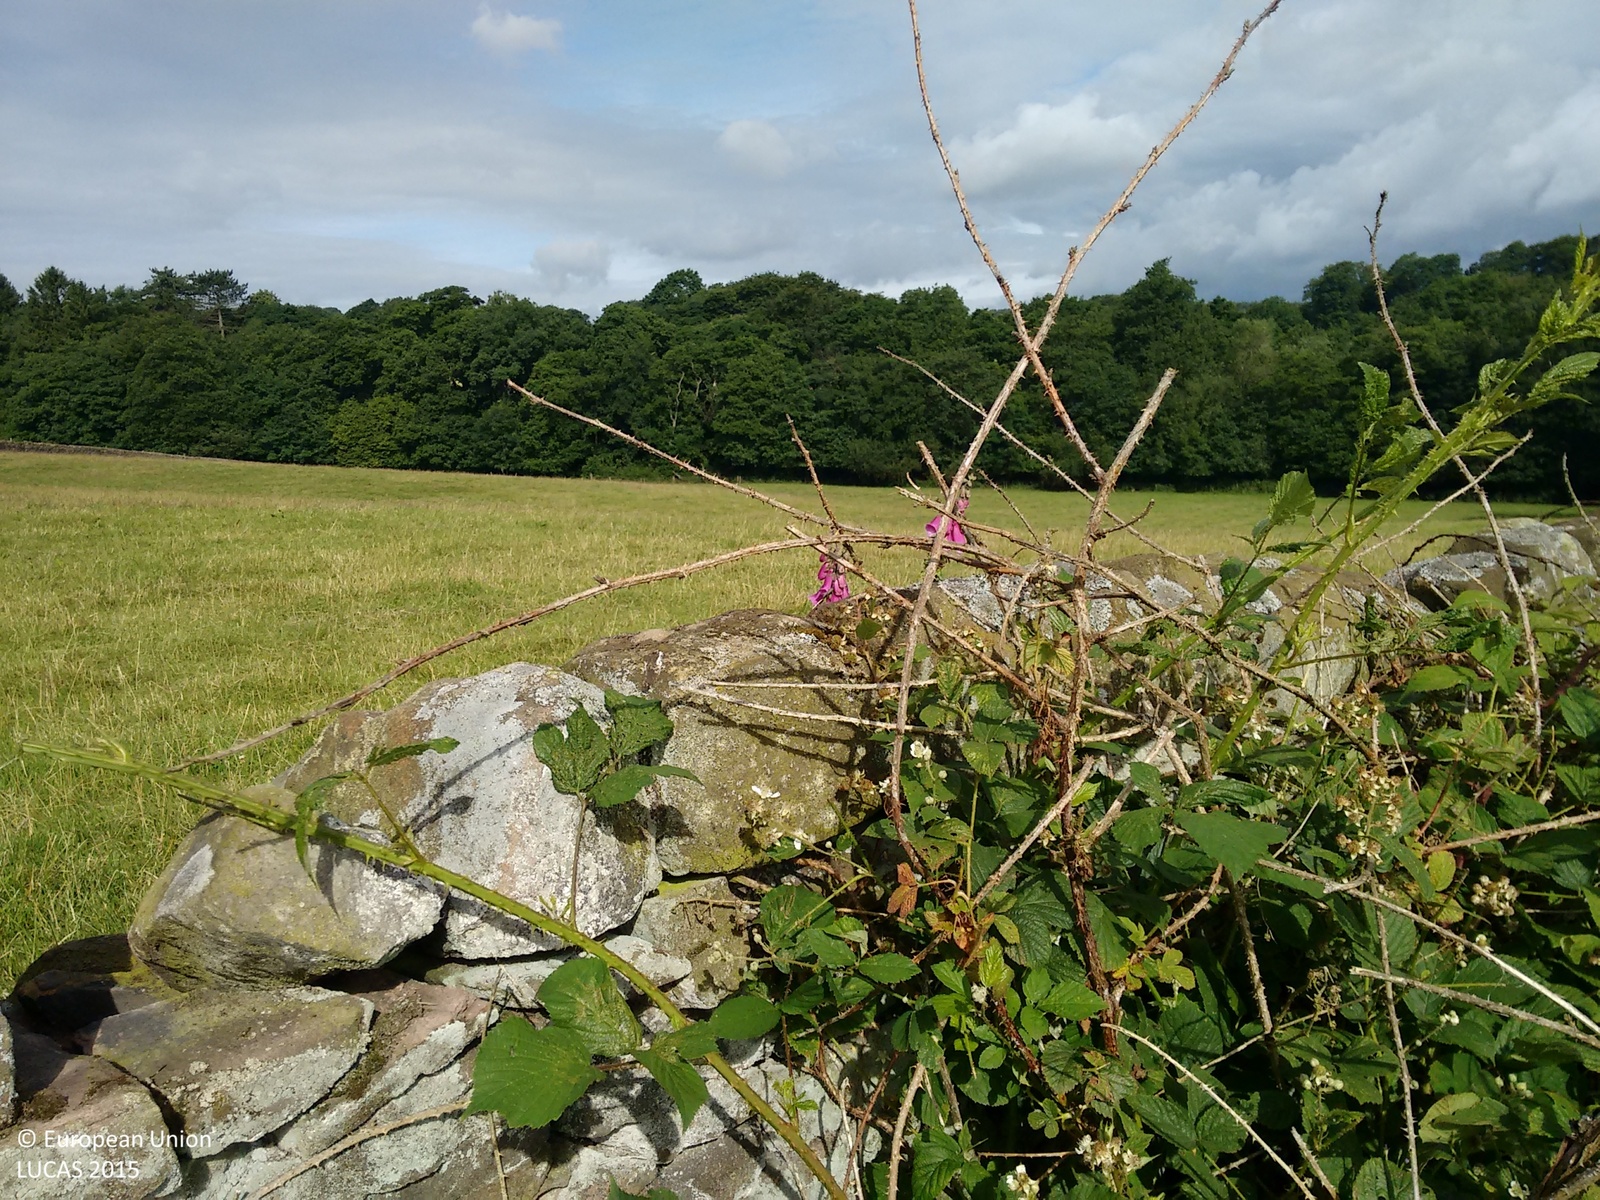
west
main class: Grassland
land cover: Grassland without tree/shrub cover
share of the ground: > 75 %
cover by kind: herbaceous plants 100 %
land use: Agriculture (excluding fallow land and kitchen gardens)
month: July
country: GB
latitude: 53.0851
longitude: -1.5321
